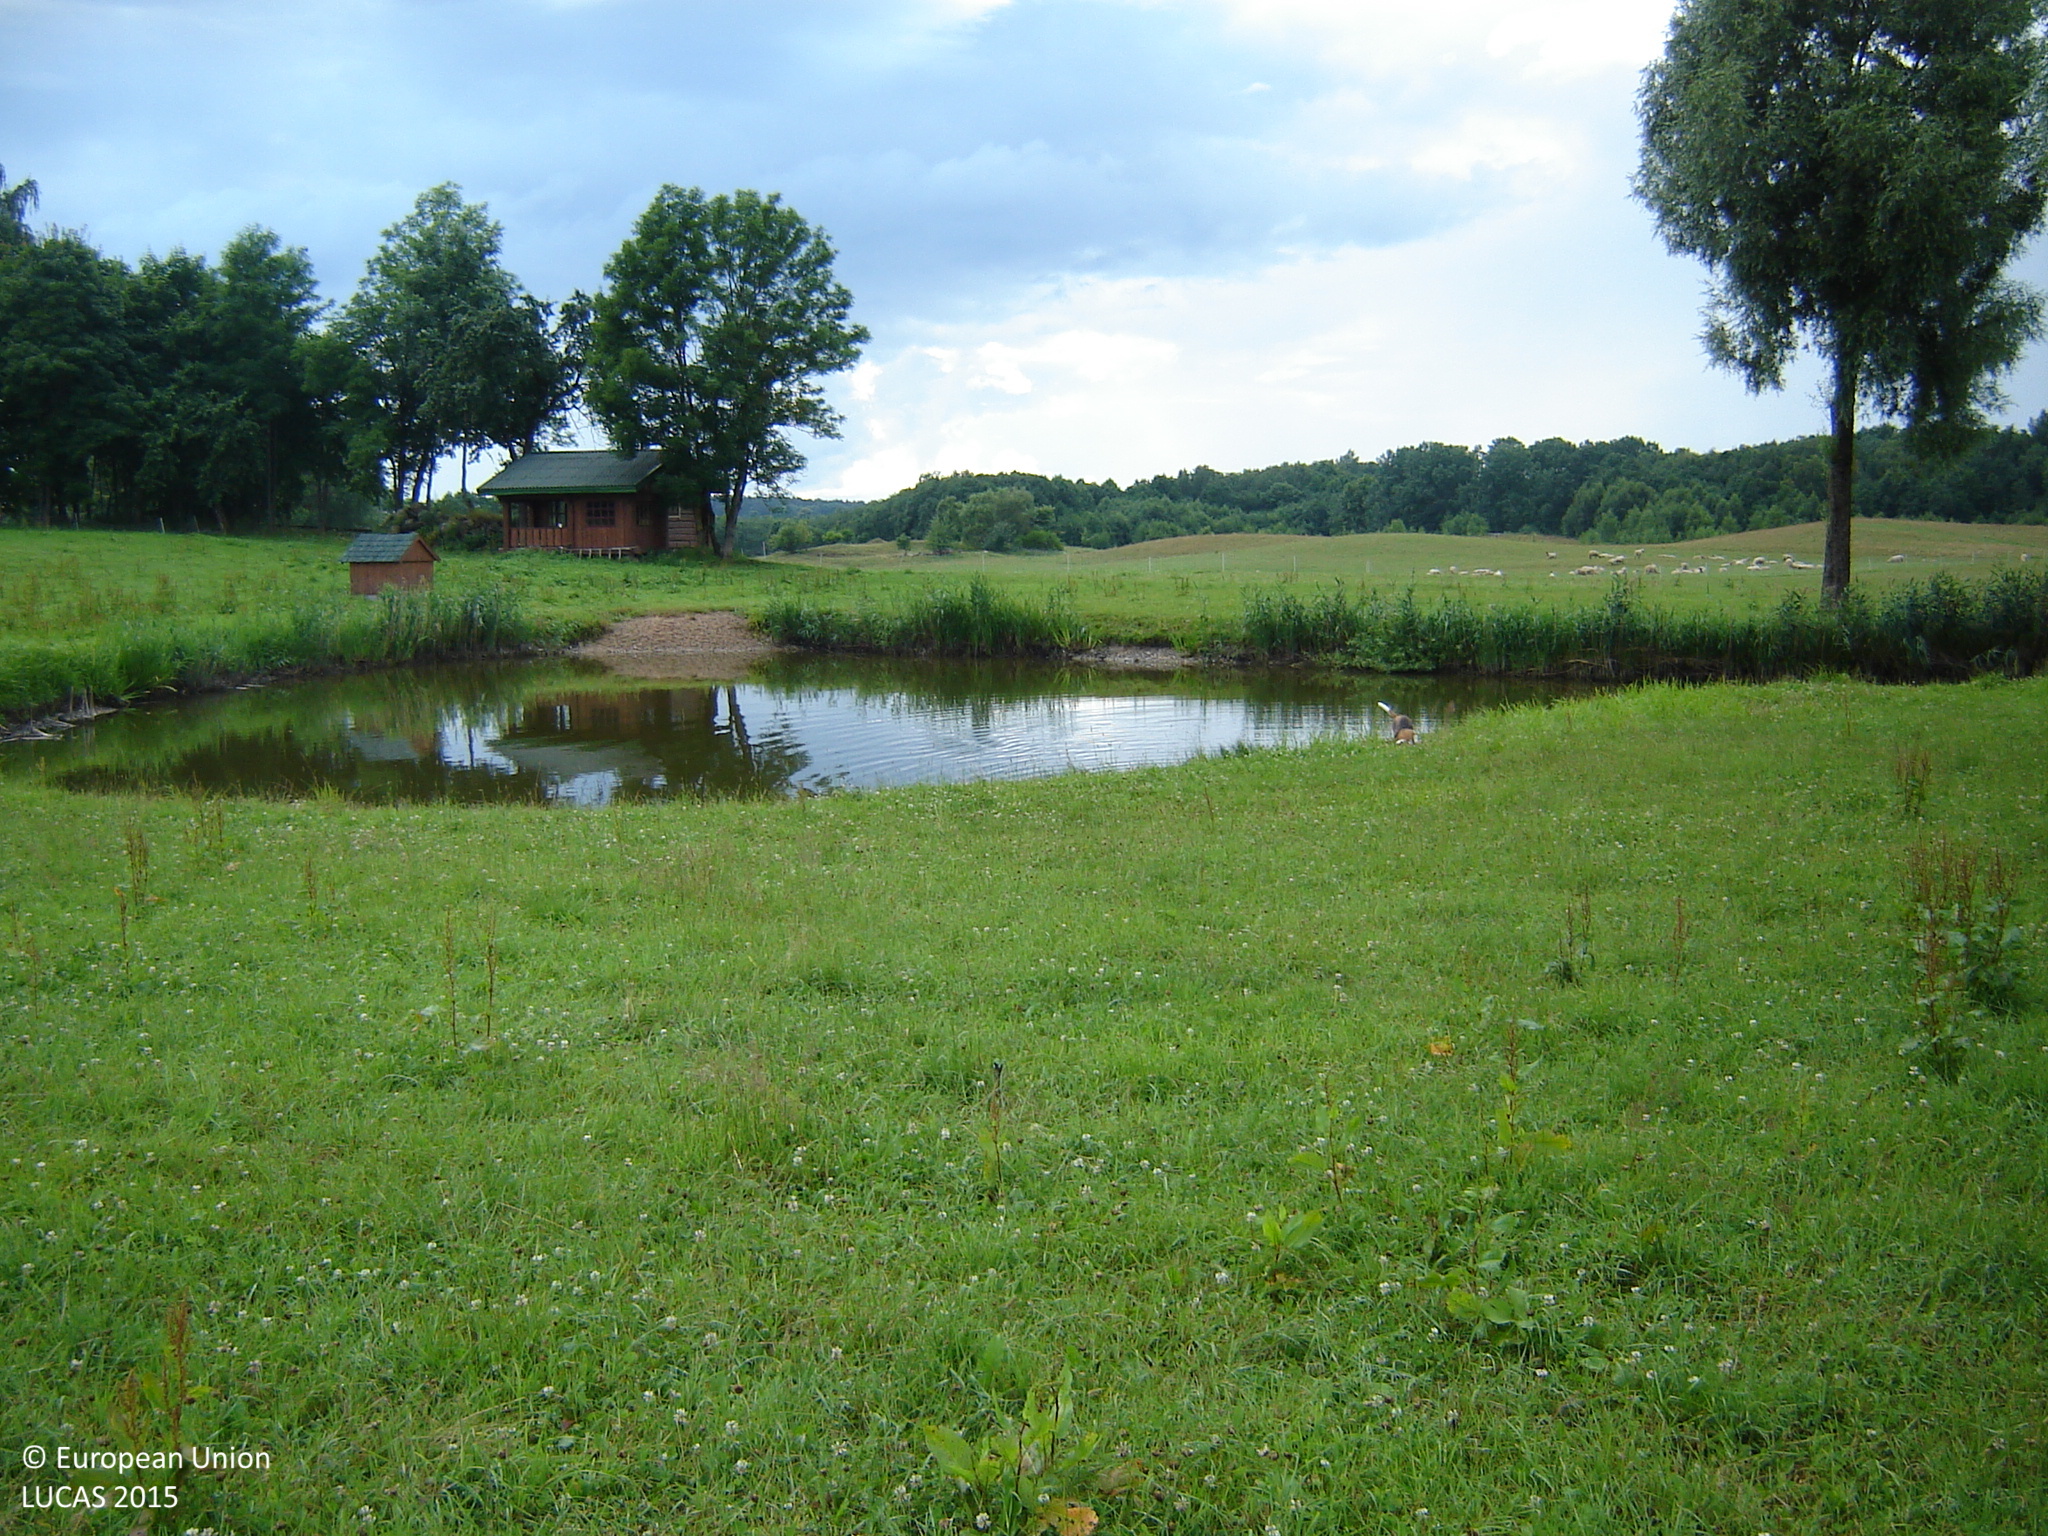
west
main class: Grassland
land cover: Grassland without tree/shrub cover
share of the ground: > 75 %
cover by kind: herbaceous plants 100 %
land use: Agriculture (excluding fallow land and kitchen gardens)
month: July
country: LT
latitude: 55.3415
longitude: 25.4009
